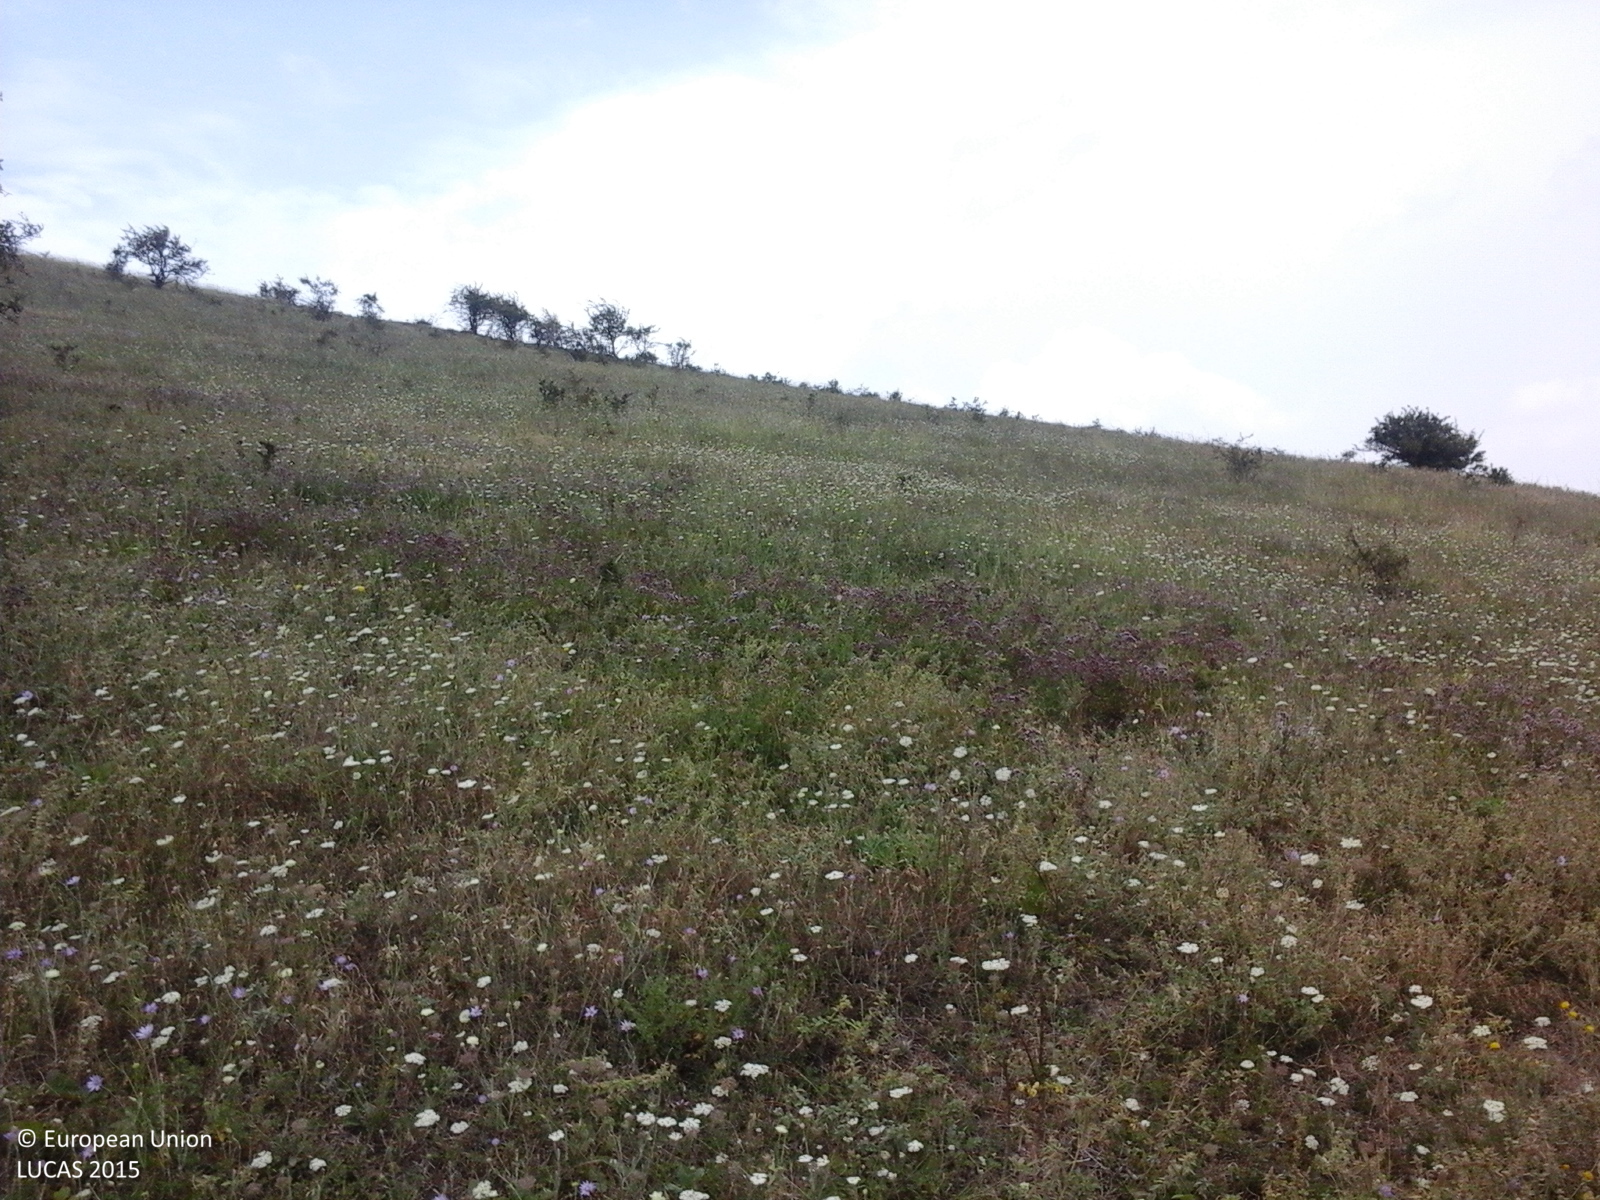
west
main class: Grassland
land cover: Grassland with sparse tree/shrub cover
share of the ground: > 75 %
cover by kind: herbaceous plants 85 %, shrubs 10 %, broadleaved forest trees 5 %
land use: Agriculture (excluding fallow land and kitchen gardens)
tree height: < 5 m
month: July
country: RO
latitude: 45.0757
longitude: 28.7736
